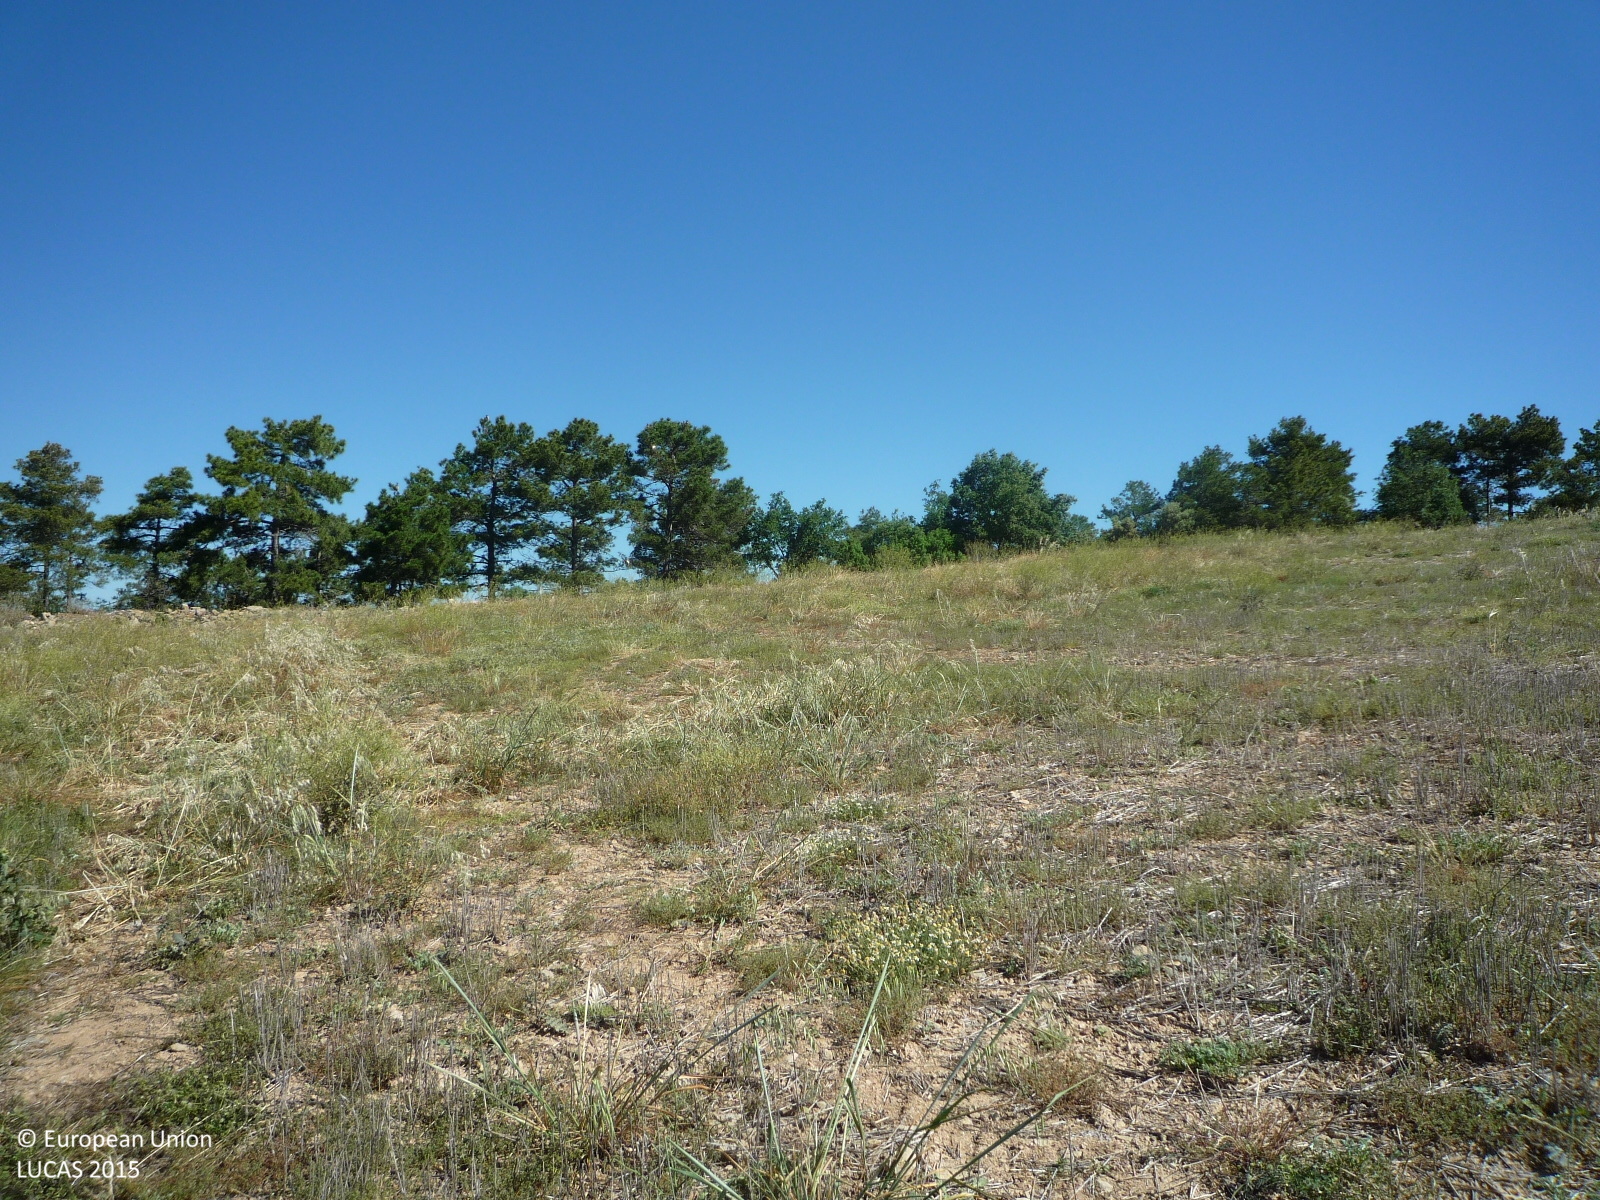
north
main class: Grassland
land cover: Spontaneously vegetated surfaces
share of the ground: > 75 %
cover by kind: herbaceous plants 100 %
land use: Agriculture (excluding fallow land and kitchen gardens)
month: May
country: ES
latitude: 41.8723
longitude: 1.6399
